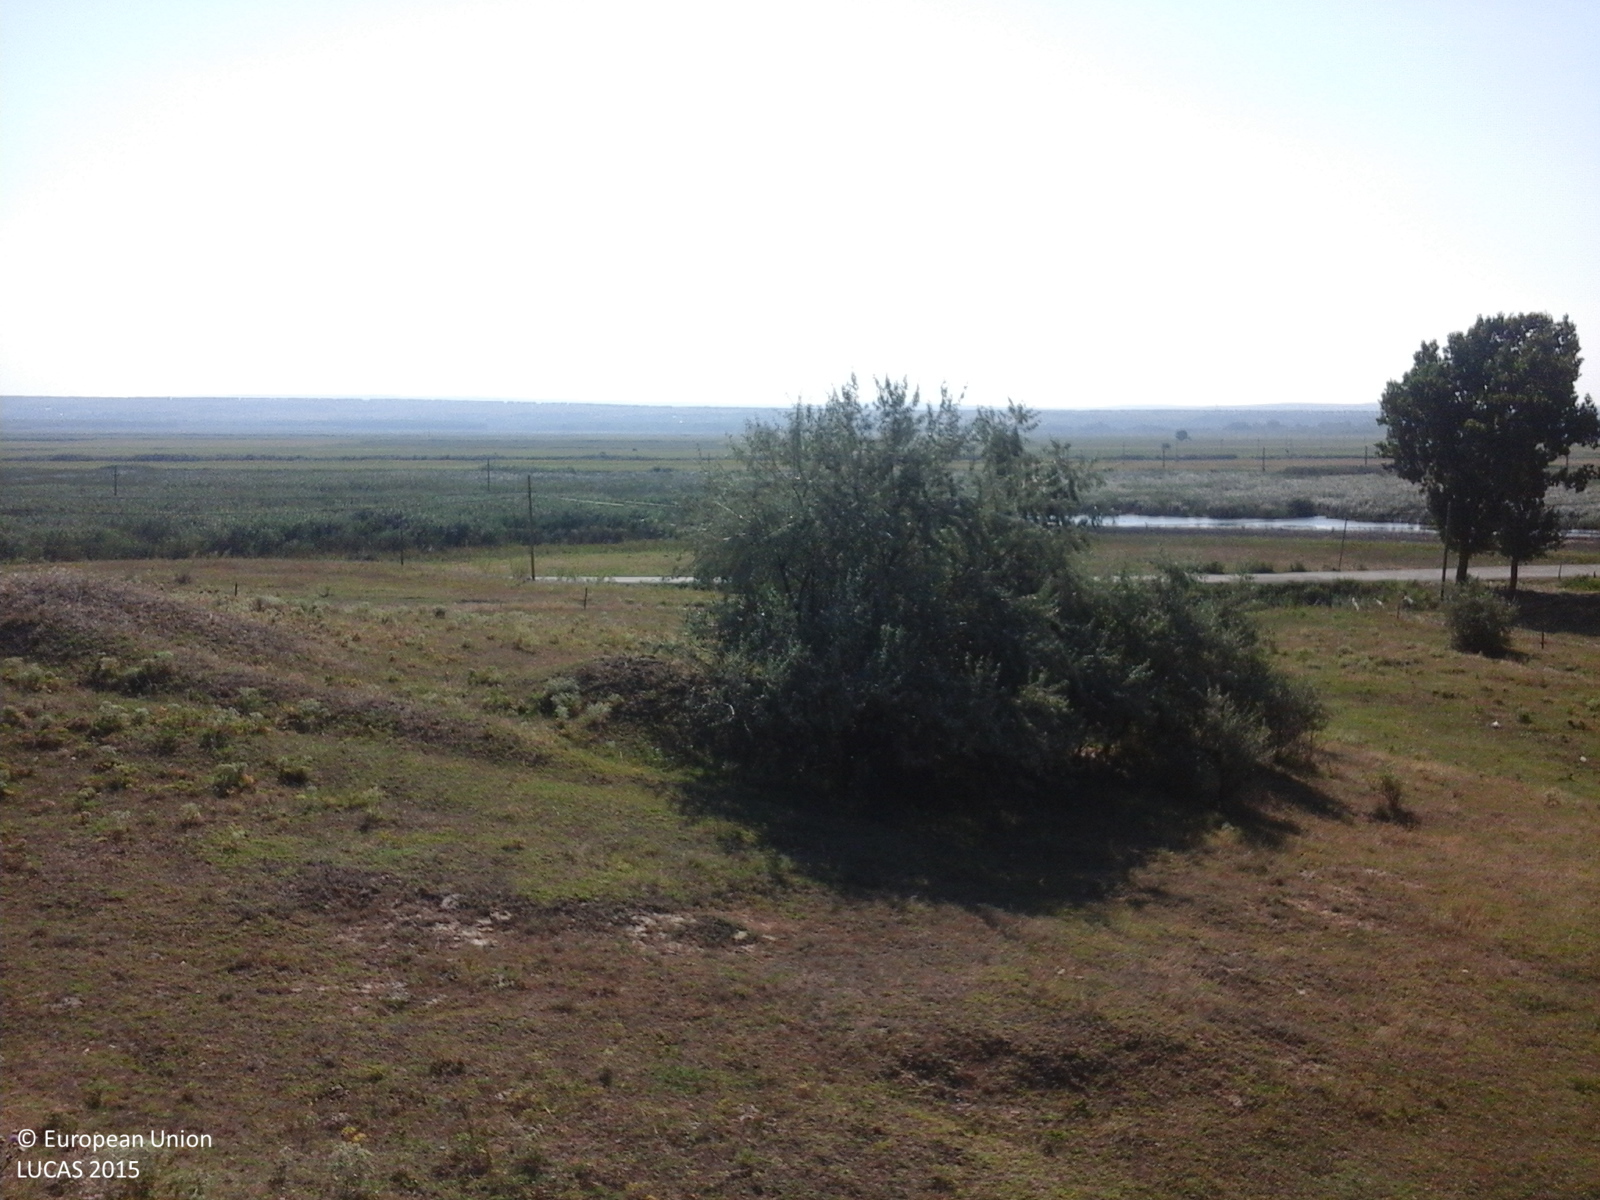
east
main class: Grassland
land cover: Grassland with sparse tree/shrub cover
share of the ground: > 75 %
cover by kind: herbaceous plants 85 %, shrubs 10 %, broadleaved forest trees 5 %
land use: Agriculture (excluding fallow land and kitchen gardens)
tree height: < 5 m
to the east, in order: Grassland with sparse tree/shrub cover; Grassland without tree/shrub cover; Tracks; Grassland without tree/shrub cover; Tracks; Grassland without tree/shrub cover; Electric lines; Grassland without tree/shrub cover; Paved roads, cycling and walking lanes; Grassland without tree/shrub cover; Electric lines; Spontaneously vegetated surfaces; Inland marshes
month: July
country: RO
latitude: 46.3138
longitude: 28.1411
